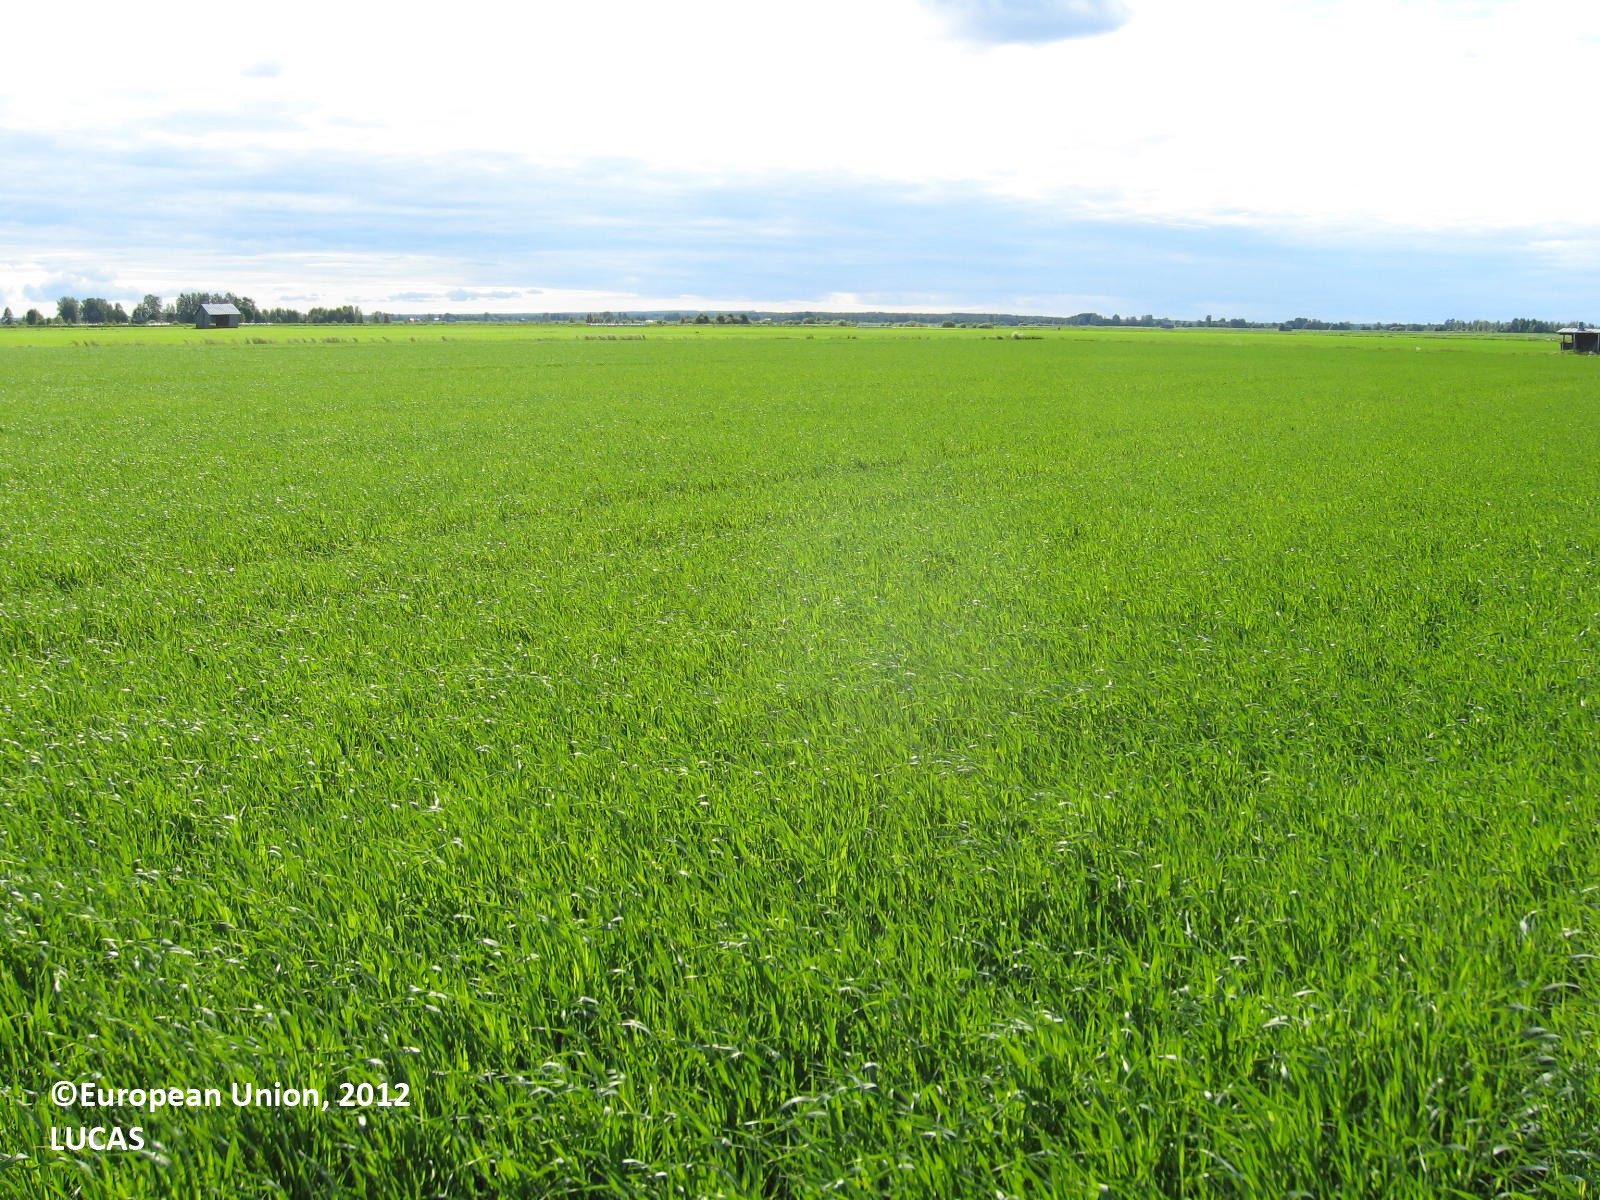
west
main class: Cropland
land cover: Barley
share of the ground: > 75 %
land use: Agriculture (excluding fallow land and kitchen gardens)
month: June
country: FI
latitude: 62.7862
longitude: 22.6985
